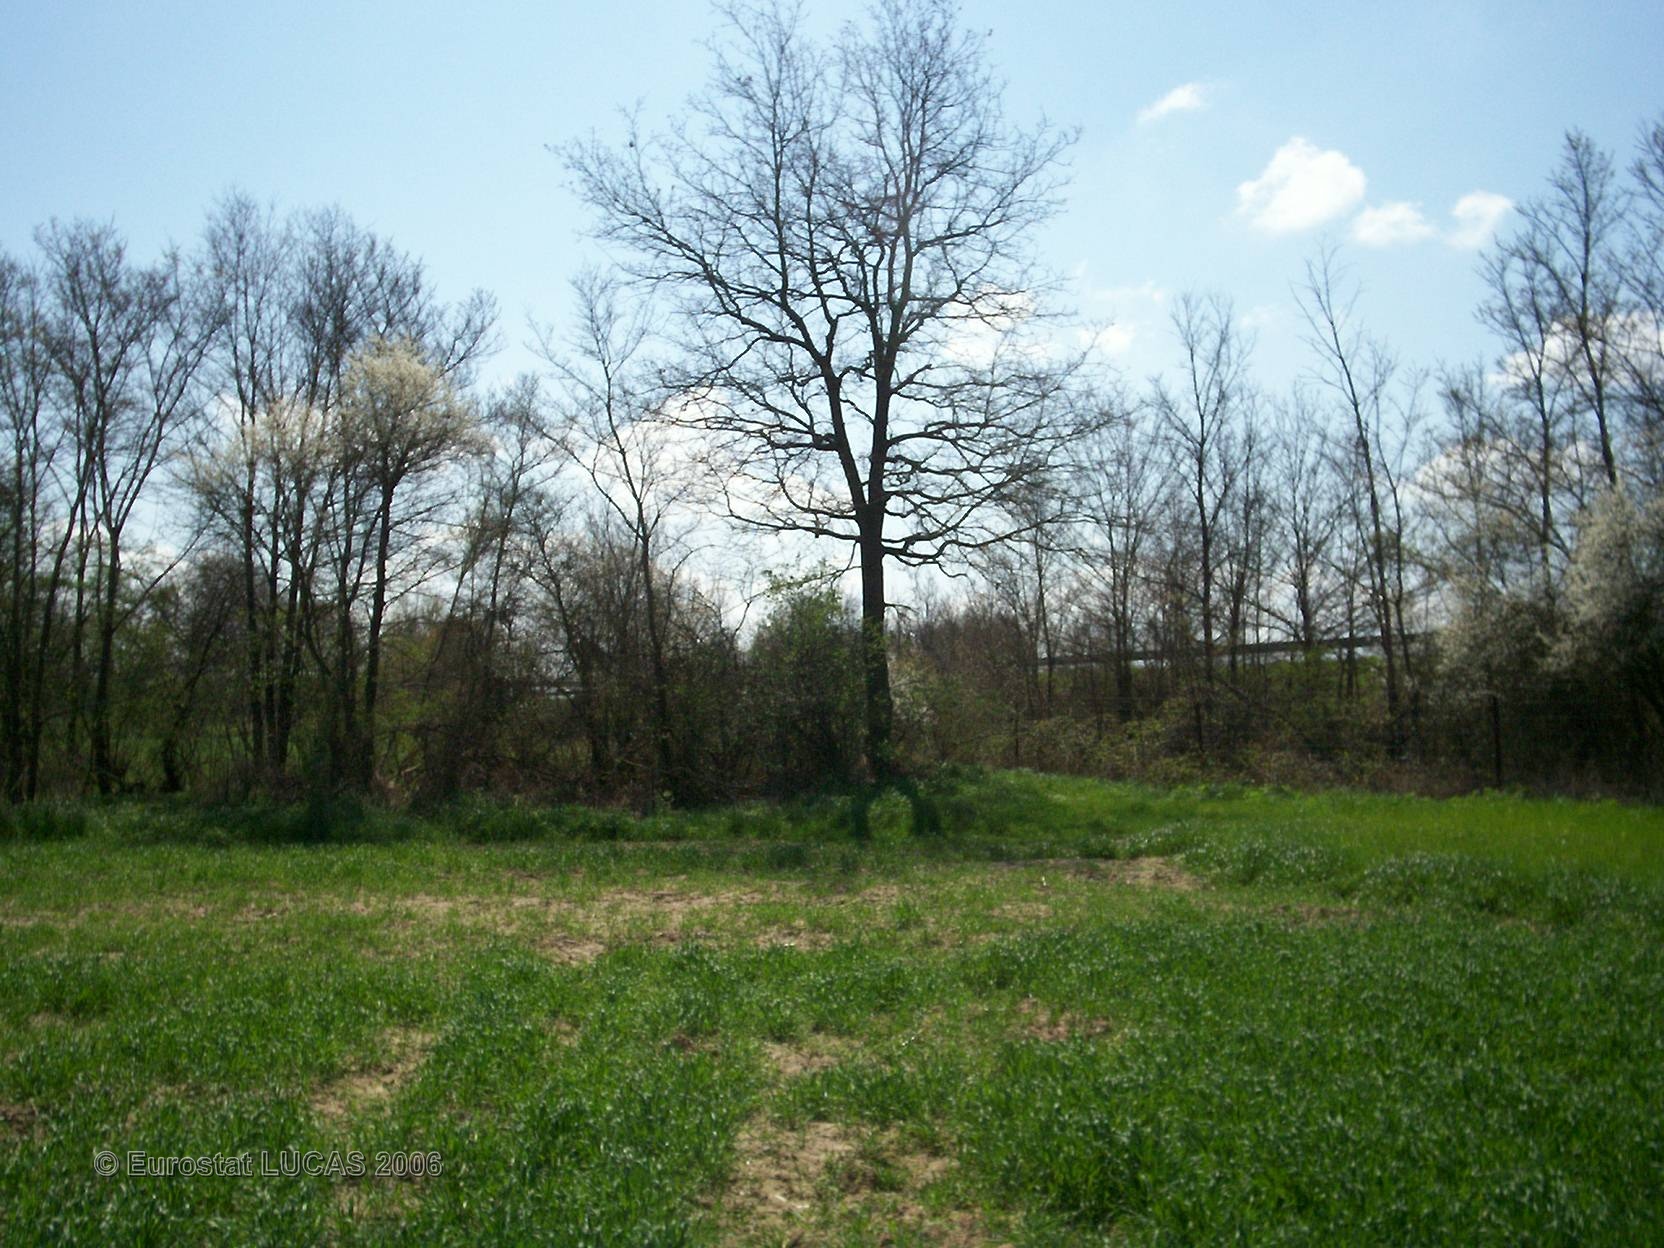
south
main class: Cropland
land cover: Common wheat
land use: Agriculture (excluding fallow land and kitchen gardens)
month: April
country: FR
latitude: 45.7413
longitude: 4.1804
